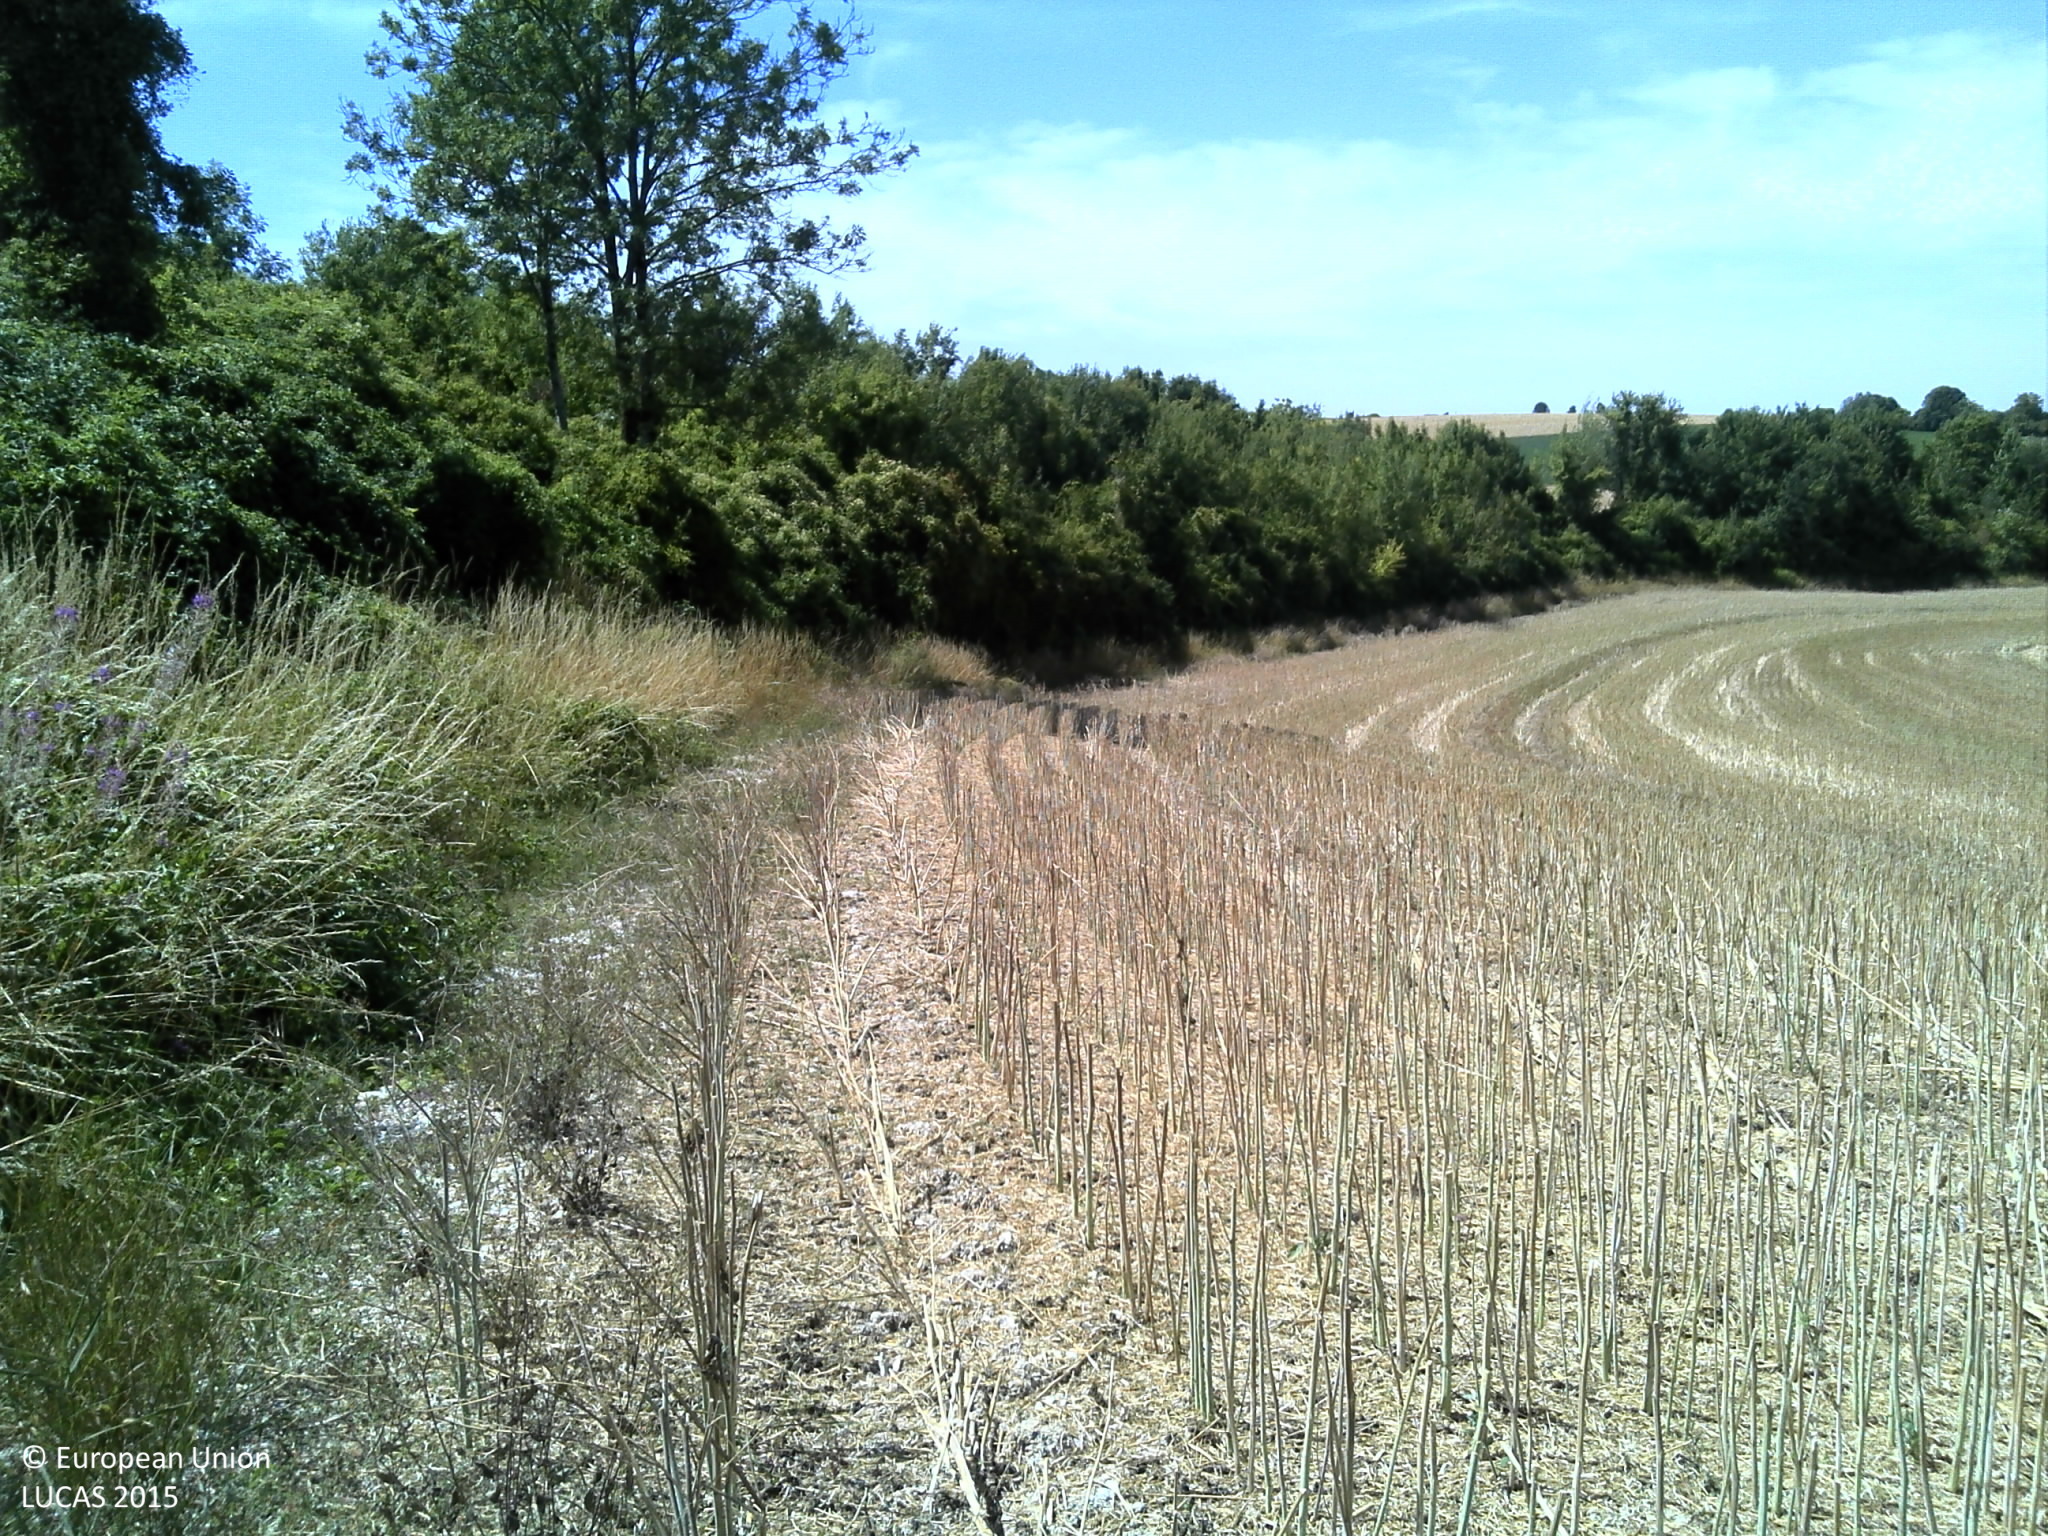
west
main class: Cropland
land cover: Rape and turnip rape
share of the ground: > 75 %
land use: Agriculture (excluding fallow land and kitchen gardens)
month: August
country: FR
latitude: 49.2490
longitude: 4.6805
